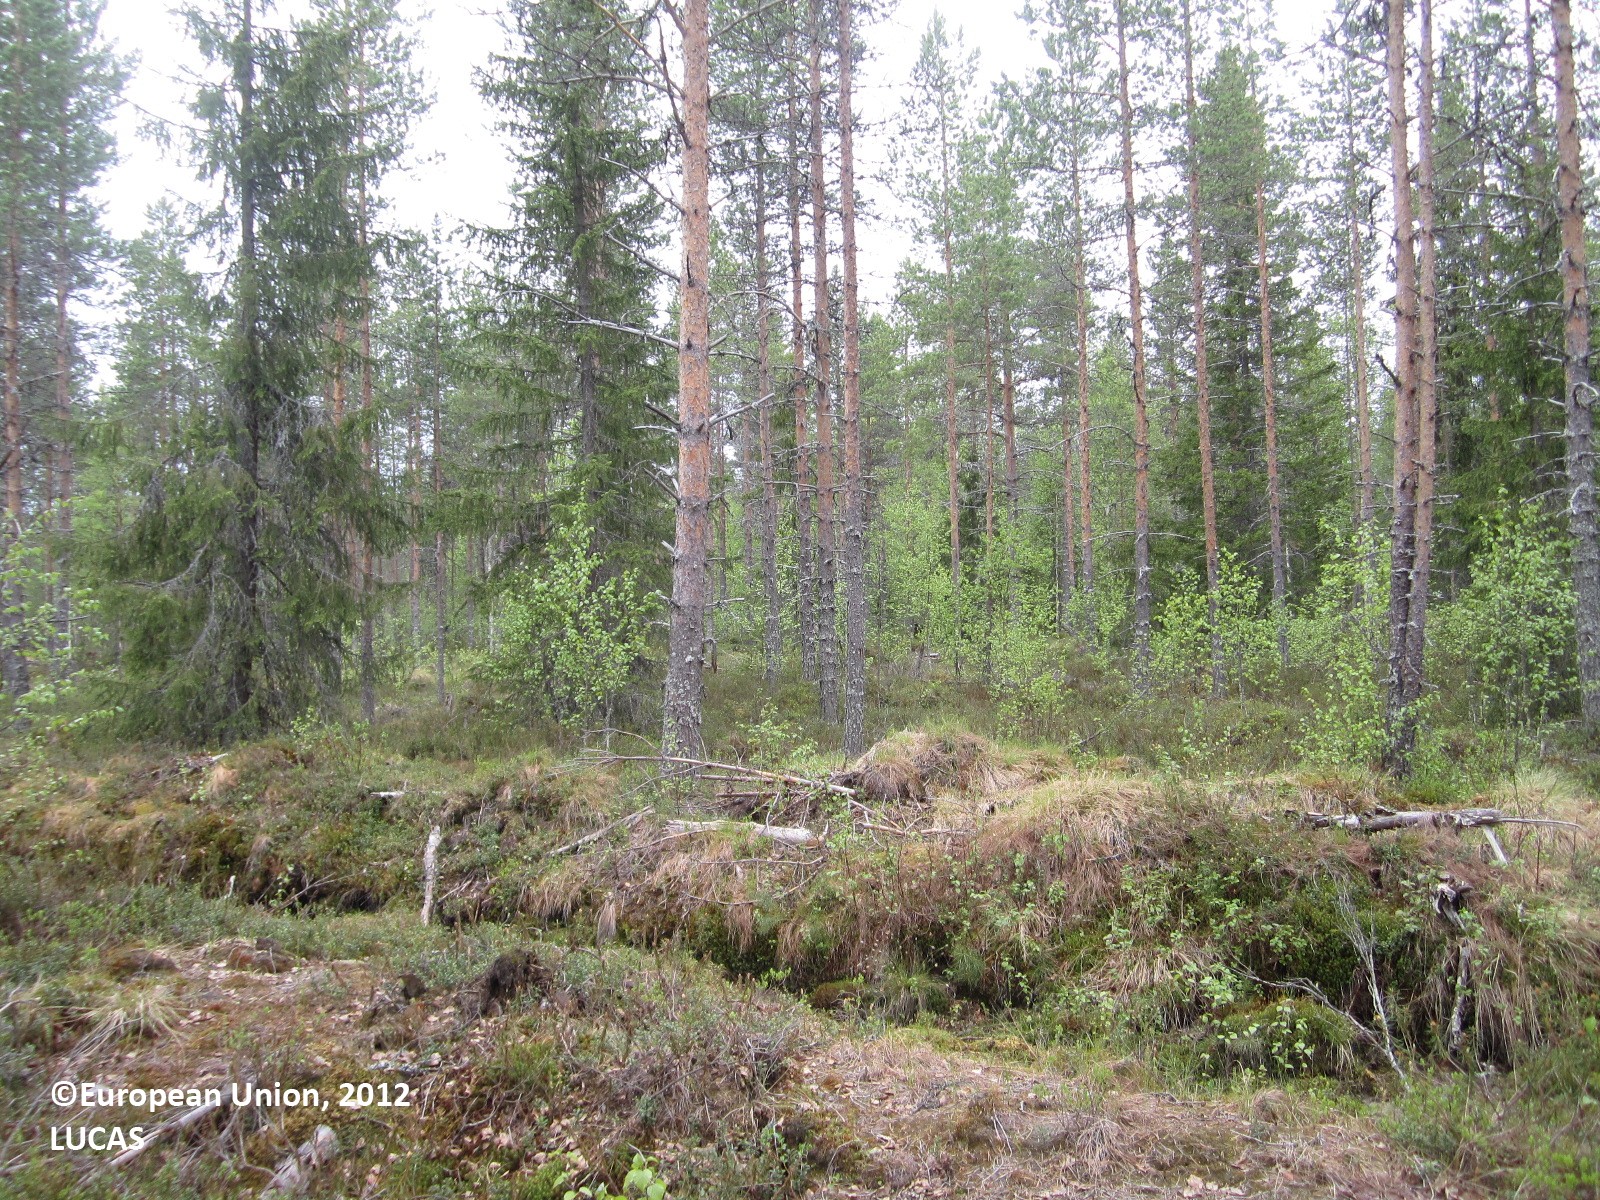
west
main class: Woodland
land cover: Pine dominated mixed woodland
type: boreal forest
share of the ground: > 75 %
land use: Forestry
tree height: > 5 m
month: June
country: FI
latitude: 64.7996
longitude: 28.7241
